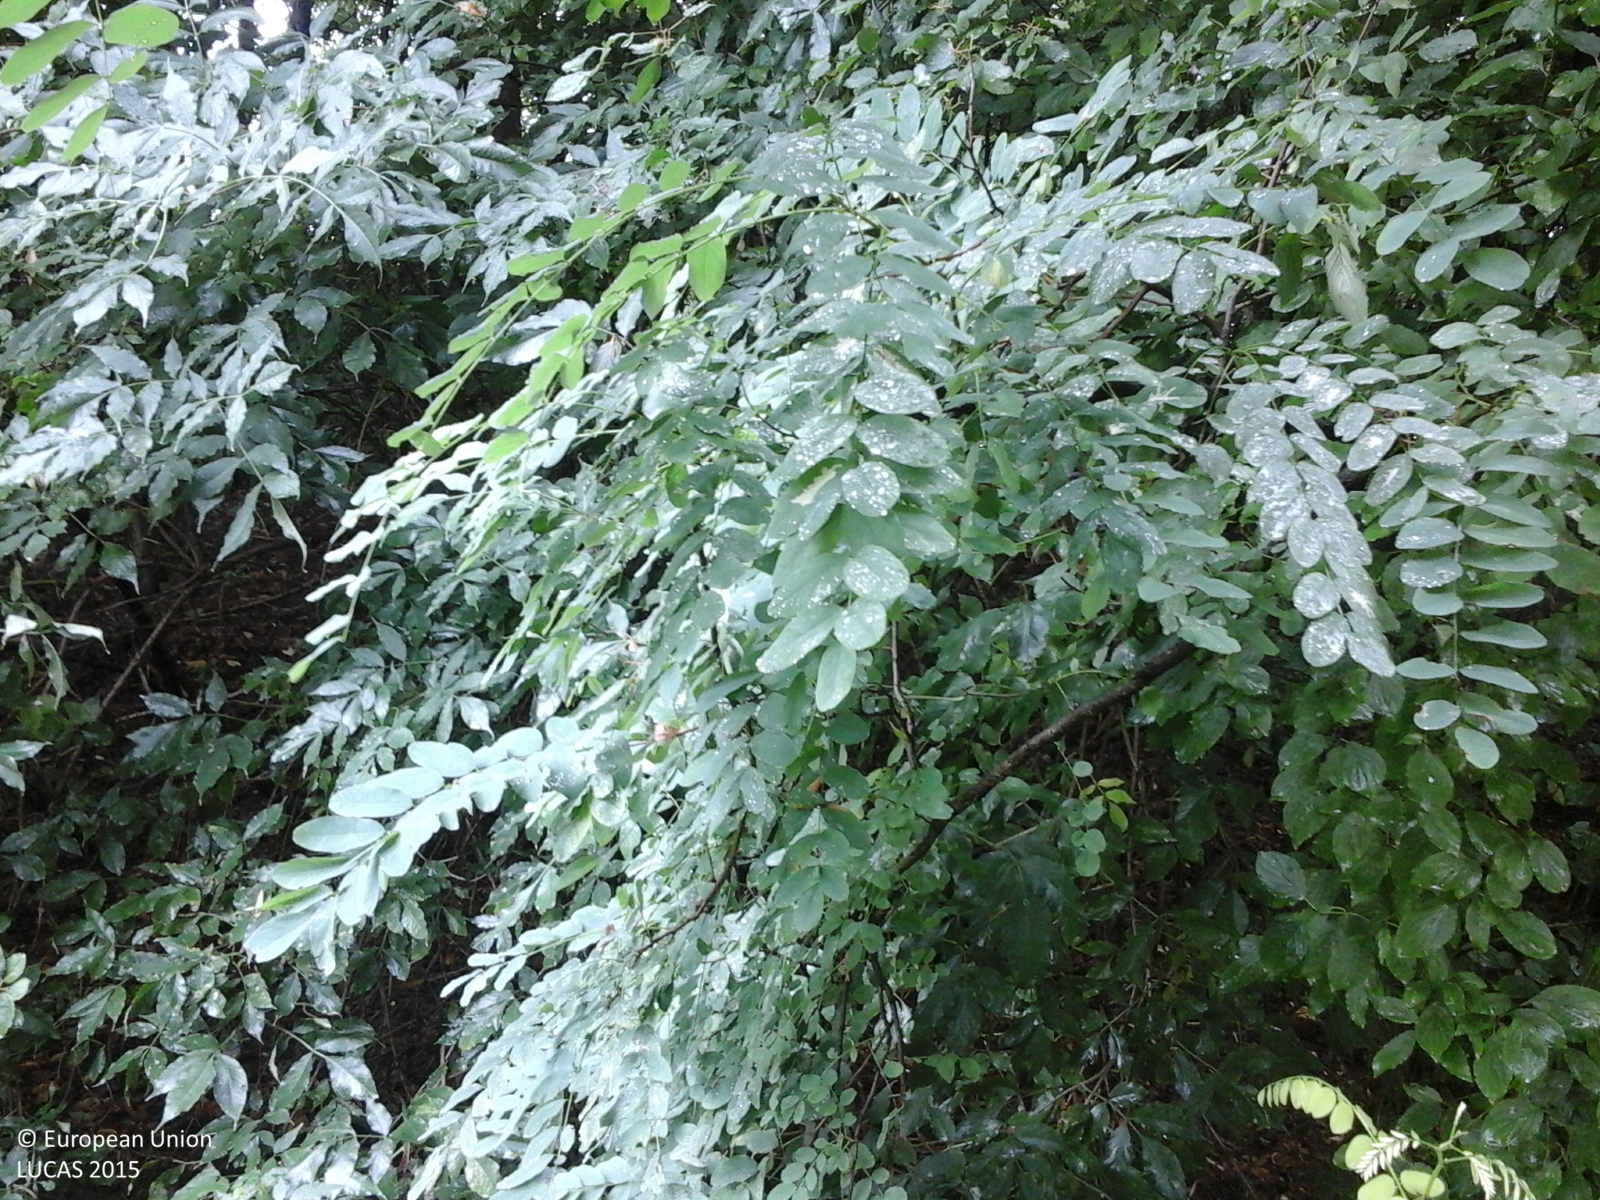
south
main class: Woodland
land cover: Broadleaved woodland
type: exotic forest
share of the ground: > 75 %
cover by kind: broadleaved forest trees 100 %
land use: Forestry
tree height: > 5 m
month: September
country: RO
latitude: 47.0304
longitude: 22.5426
